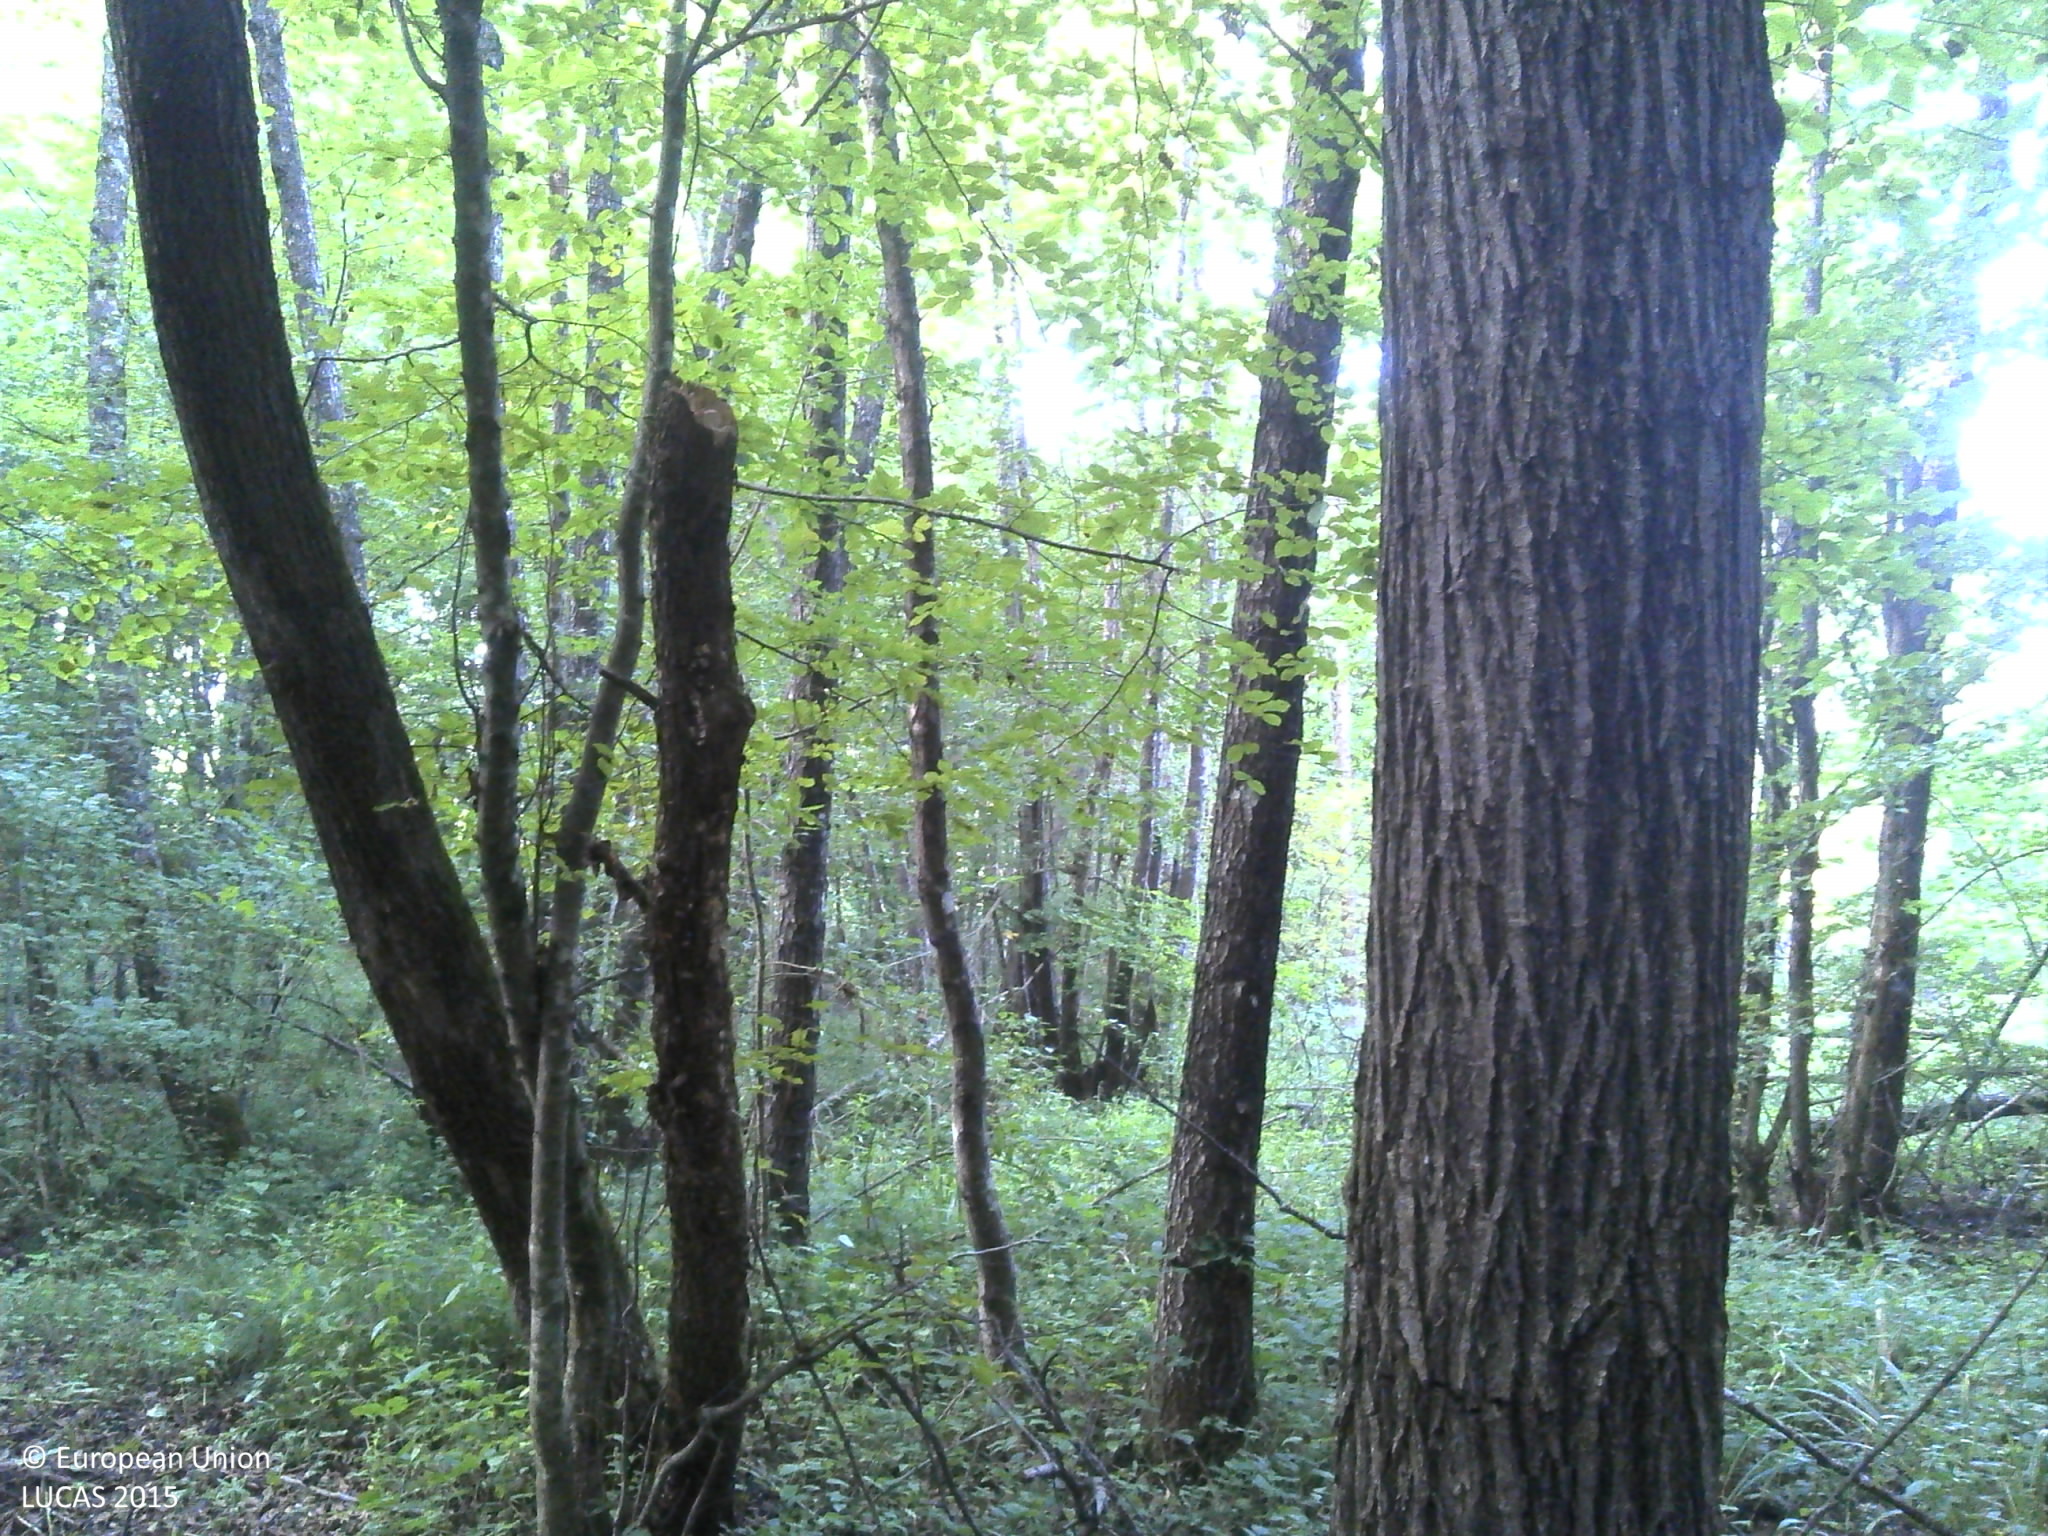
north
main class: Woodland
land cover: Broadleaved woodland
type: acidophilous oak and oak-birch forest
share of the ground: > 75 %
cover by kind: broadleaved forest trees 100 %
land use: Forestry
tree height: > 5 m
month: September
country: HR
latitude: 45.4891
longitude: 16.1262
